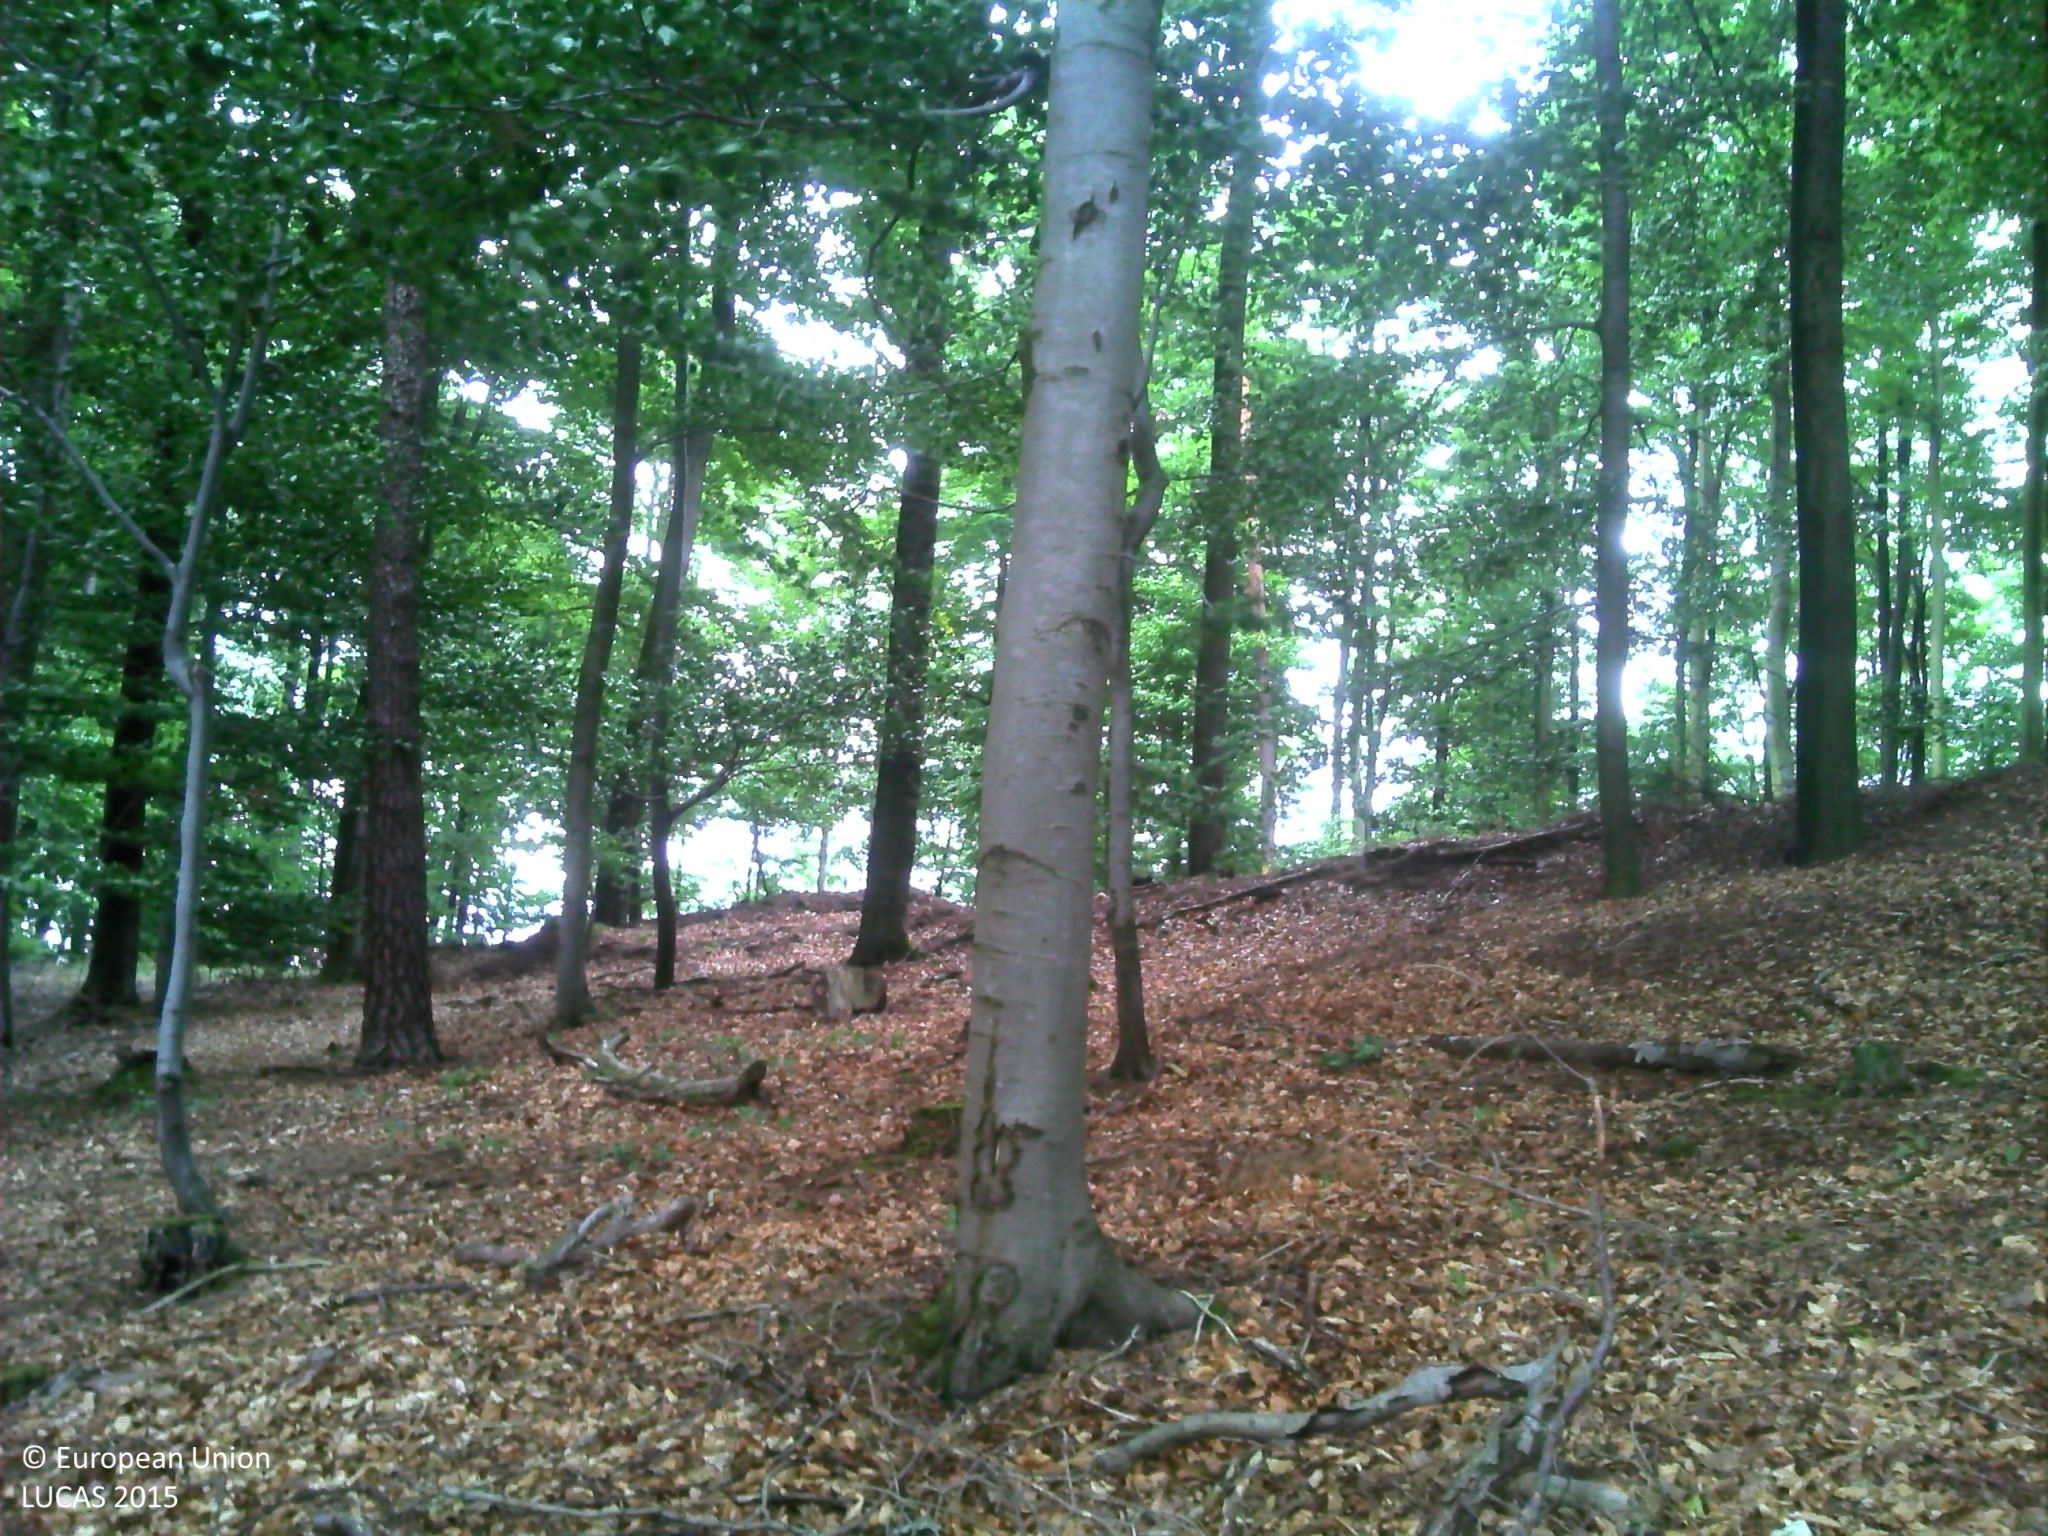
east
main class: Woodland
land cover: Pine dominated mixed woodland
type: hemiboreal forest and nemoral coniferous forest and mixed broadleaved-coniferous forest
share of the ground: > 75 %
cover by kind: broadleaved forest trees 65 %, coniferous forest trees 35 %
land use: Forestry
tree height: > 5 m
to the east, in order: Pine dominated mixed woodland; Tracks; Pine dominated mixed woodland; Broadleaved woodland
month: July
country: FR
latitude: 48.9896
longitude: 7.6091
